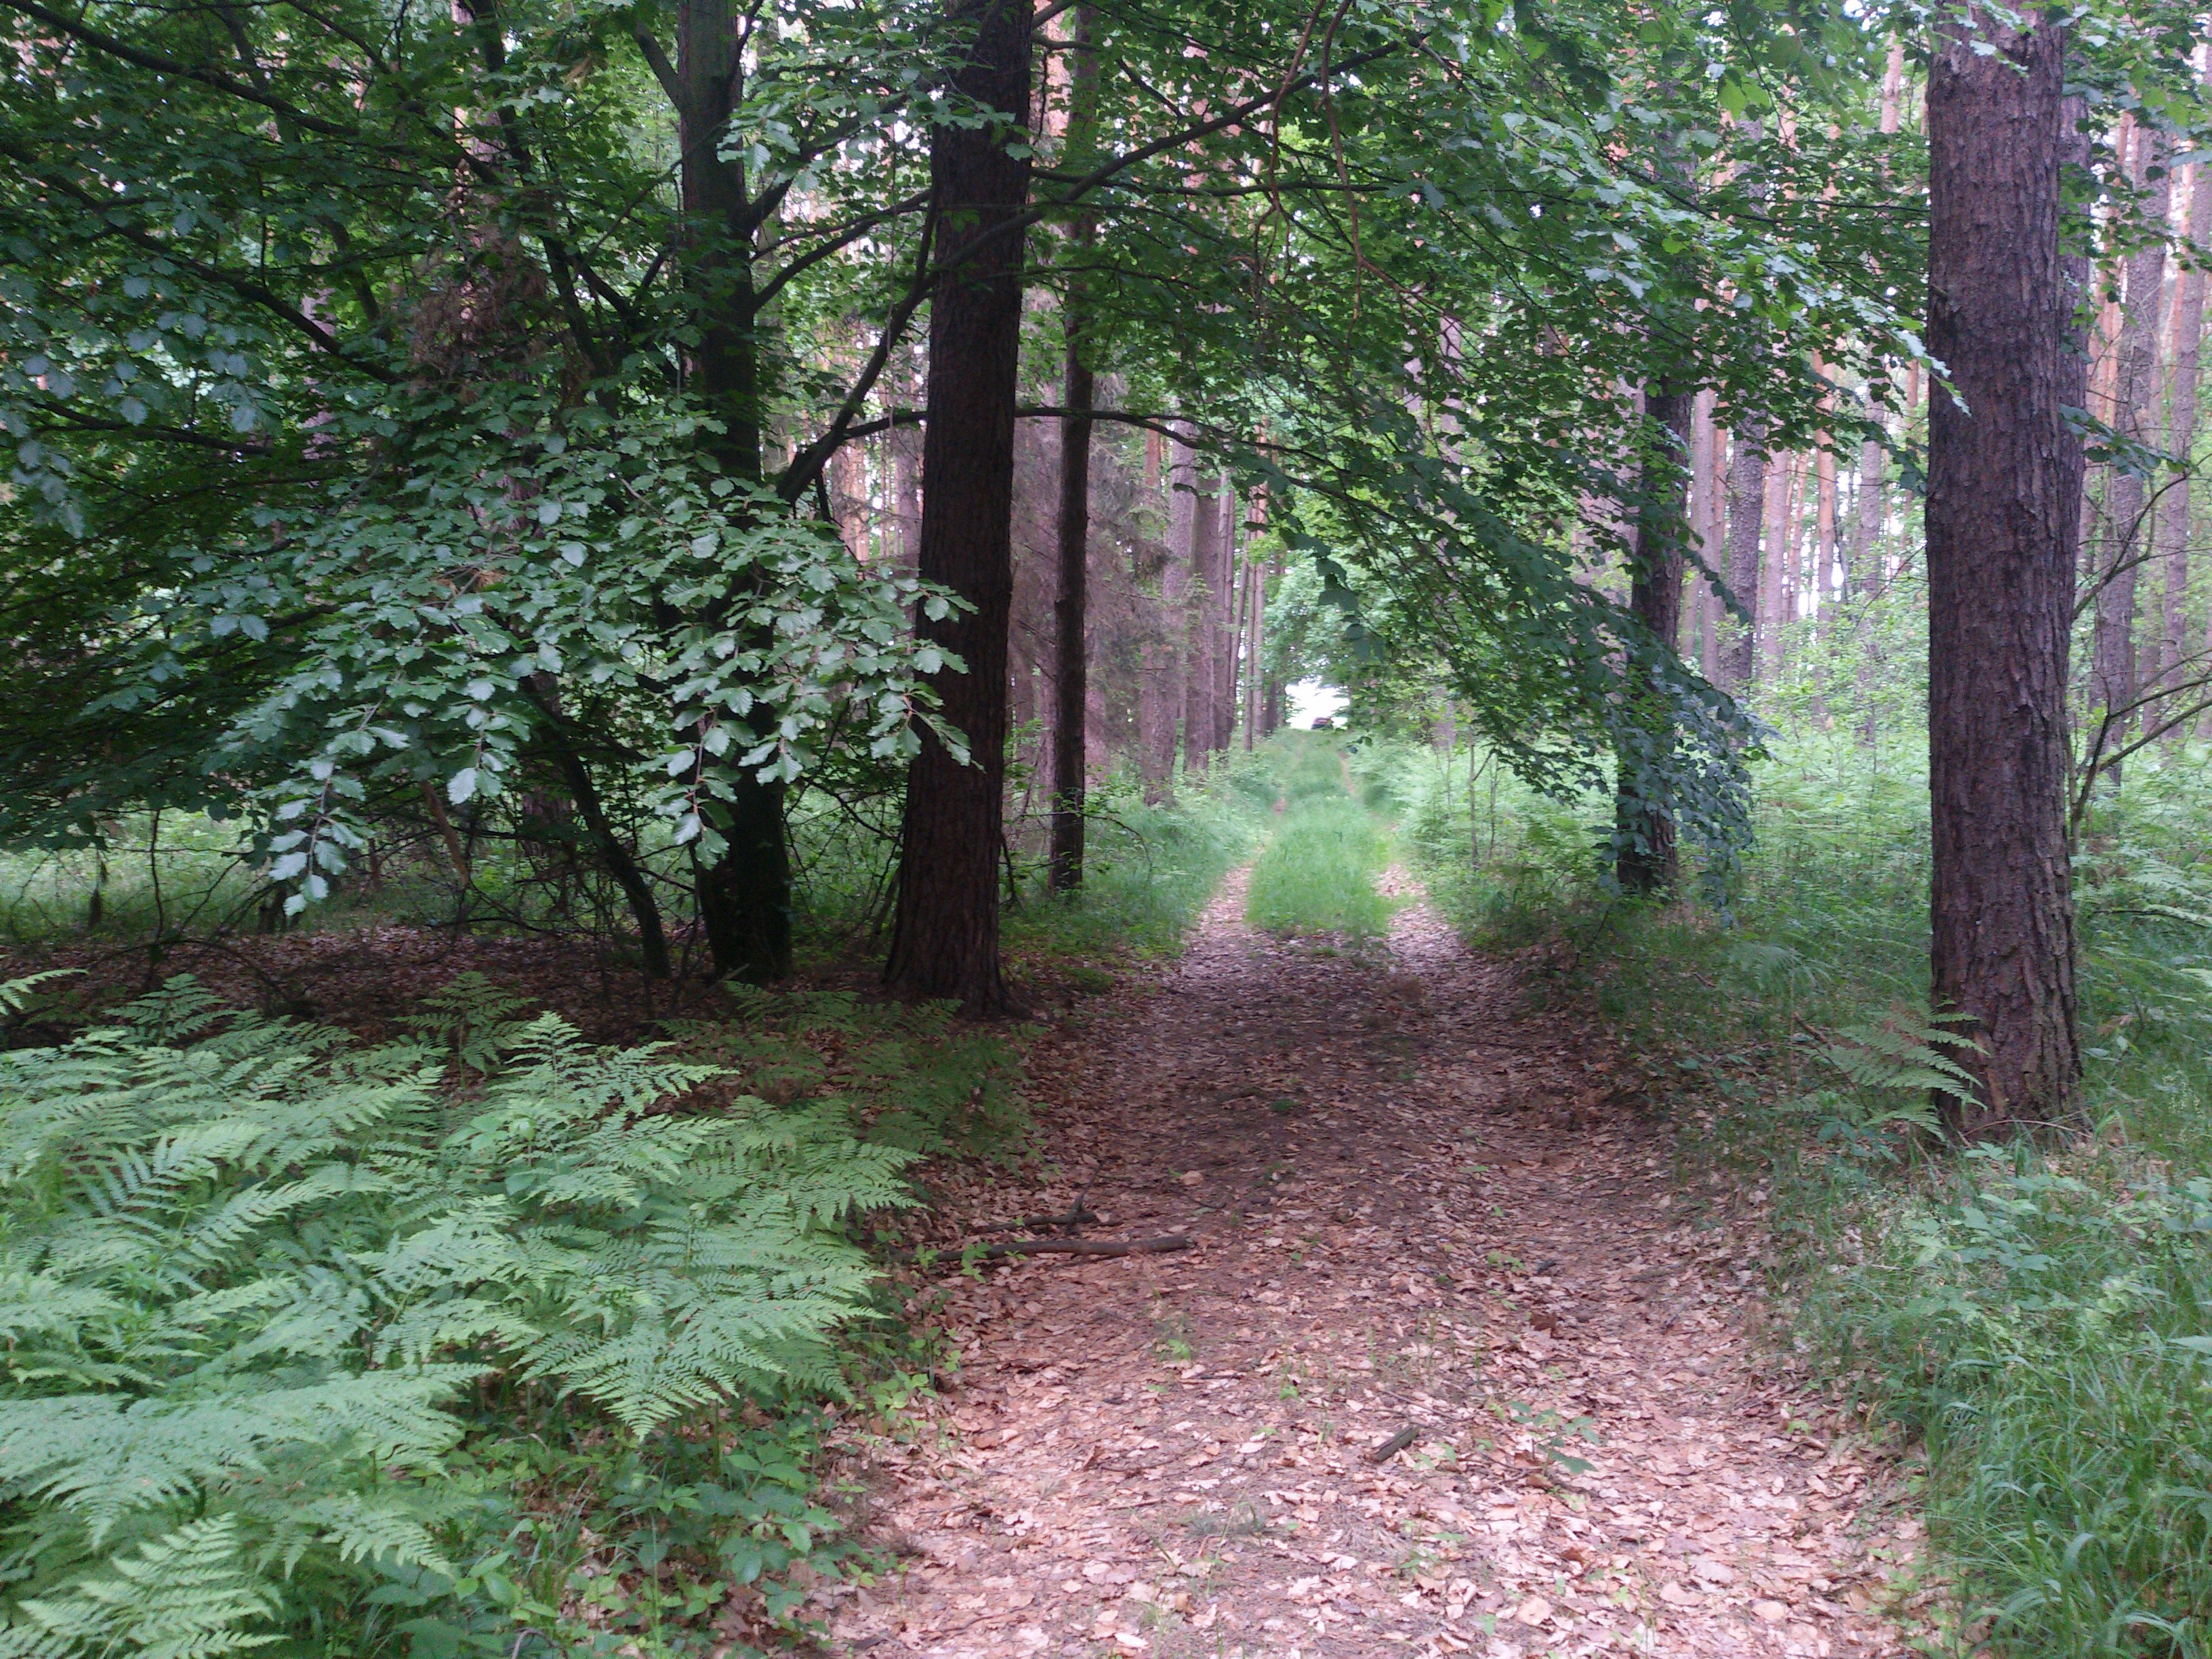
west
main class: Woodland
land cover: Pine dominated mixed woodland
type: hemiboreal forest and nemoral coniferous forest and mixed broadleaved-coniferous forest
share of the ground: > 75 %
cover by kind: coniferous forest trees 60 %, broadleaved forest trees 25 %, herbaceous plants 15 %
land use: Forestry
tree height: > 5 m
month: May
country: PL
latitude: 50.6664
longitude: 17.6679
